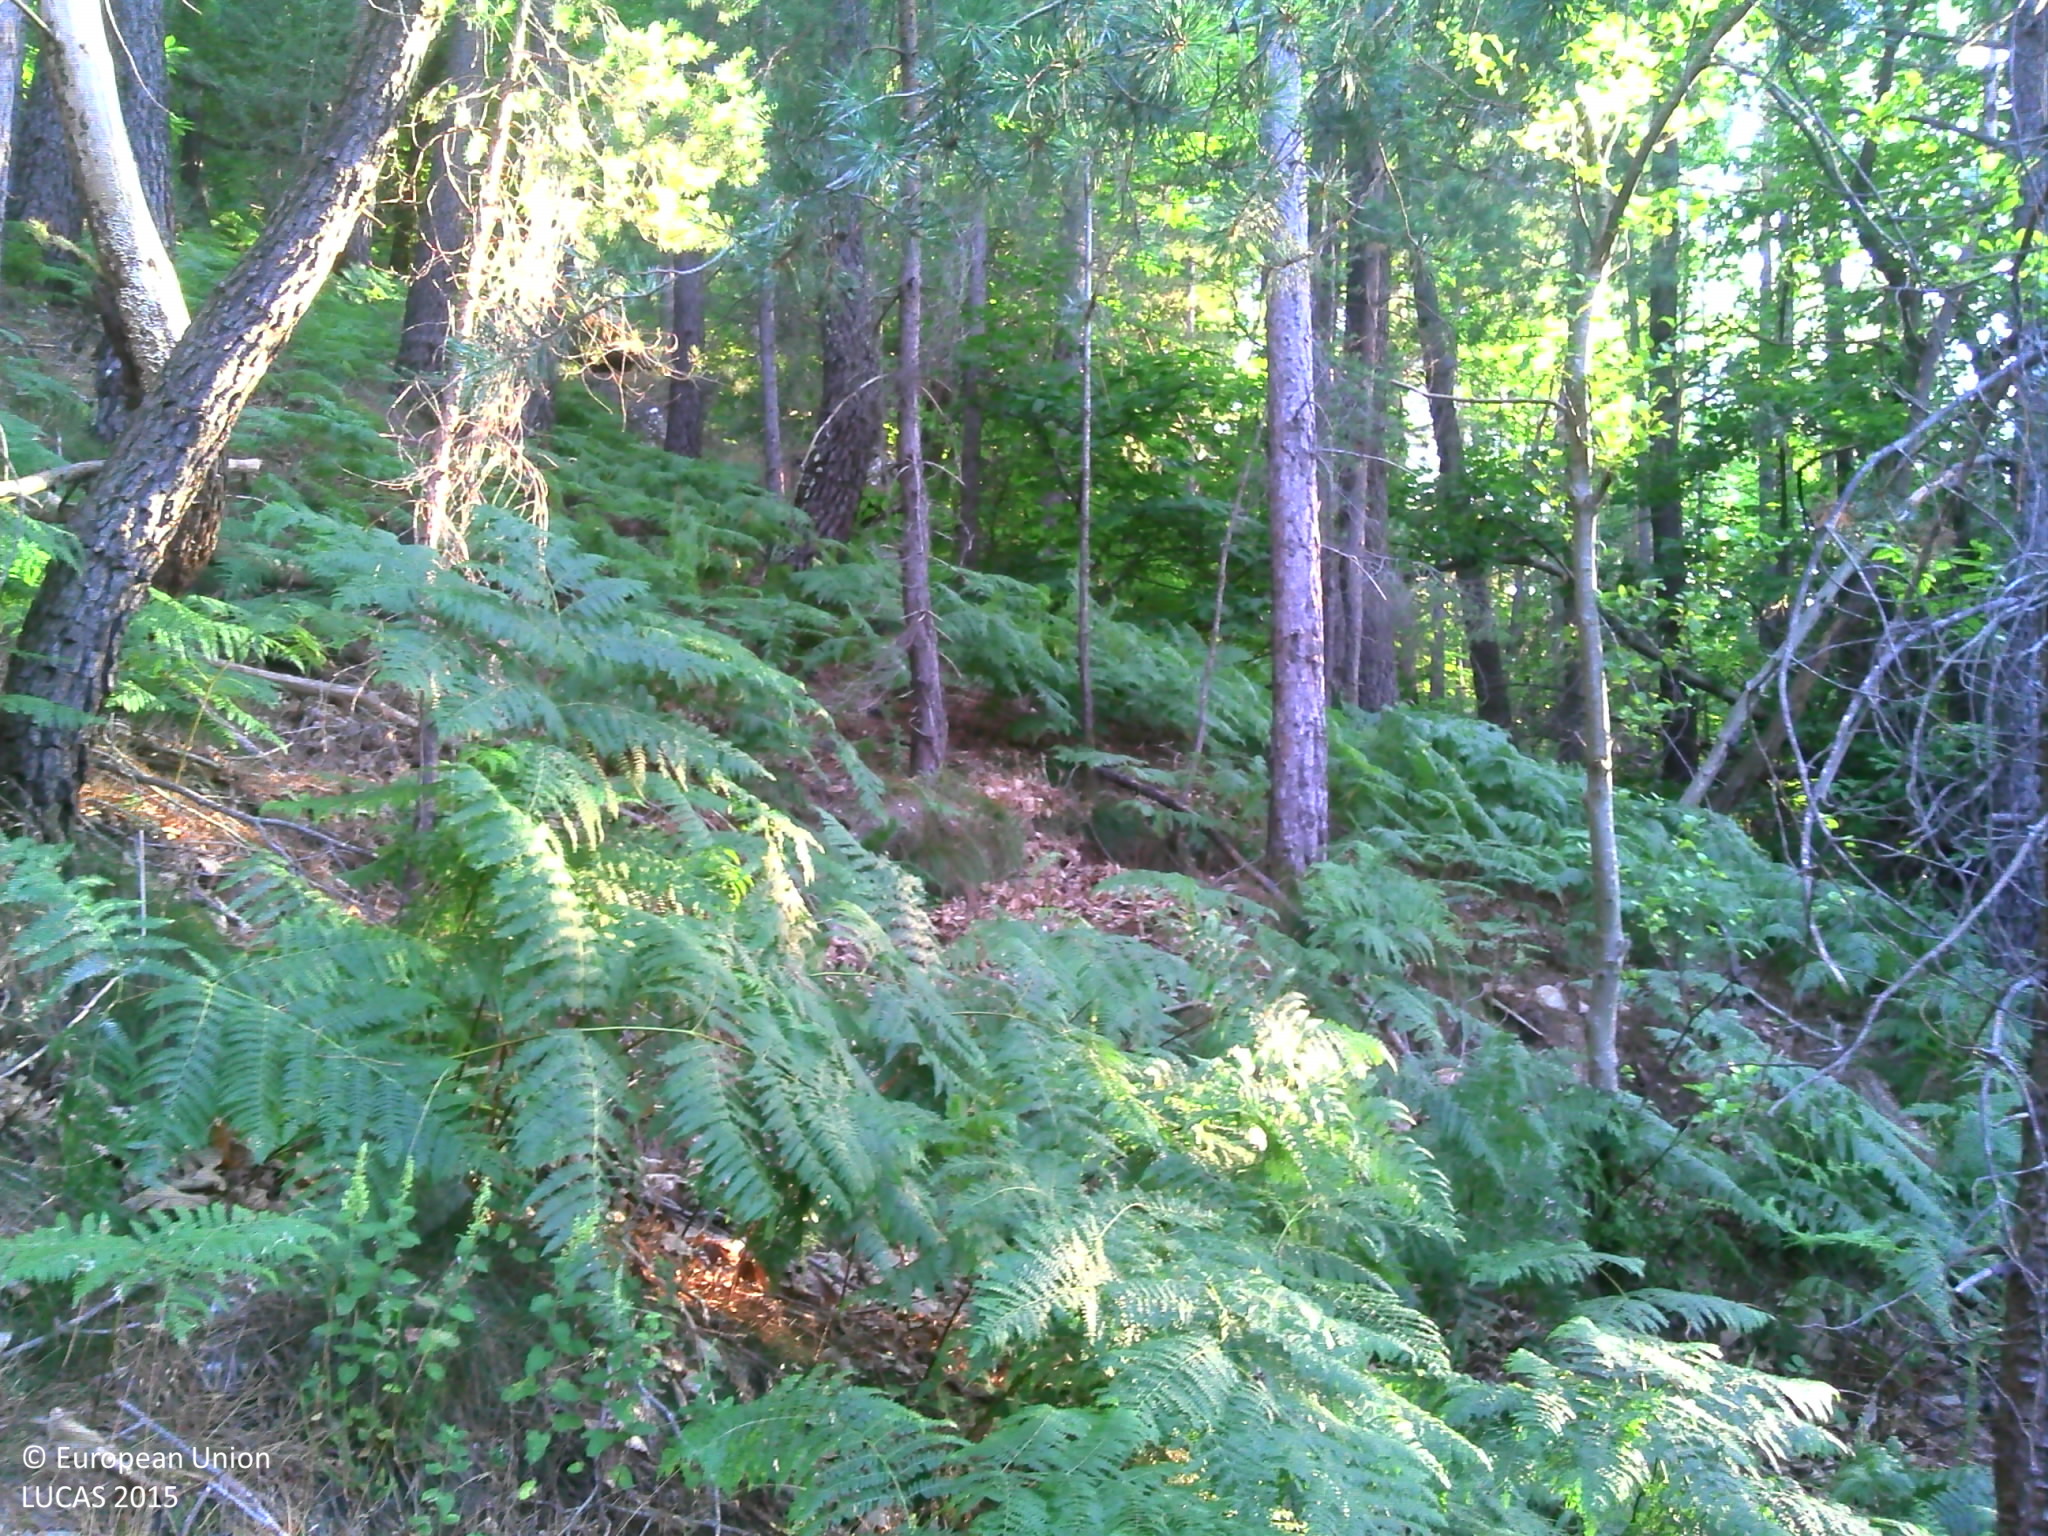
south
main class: Woodland
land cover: Pine dominated mixed woodland
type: coniferous forest of the mediterranean region
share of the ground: > 75 %
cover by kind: broadleaved forest trees 75 %, coniferous forest trees 25 %
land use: Forestry
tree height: > 5 m
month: June
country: FR
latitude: 44.2633
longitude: 3.9315
